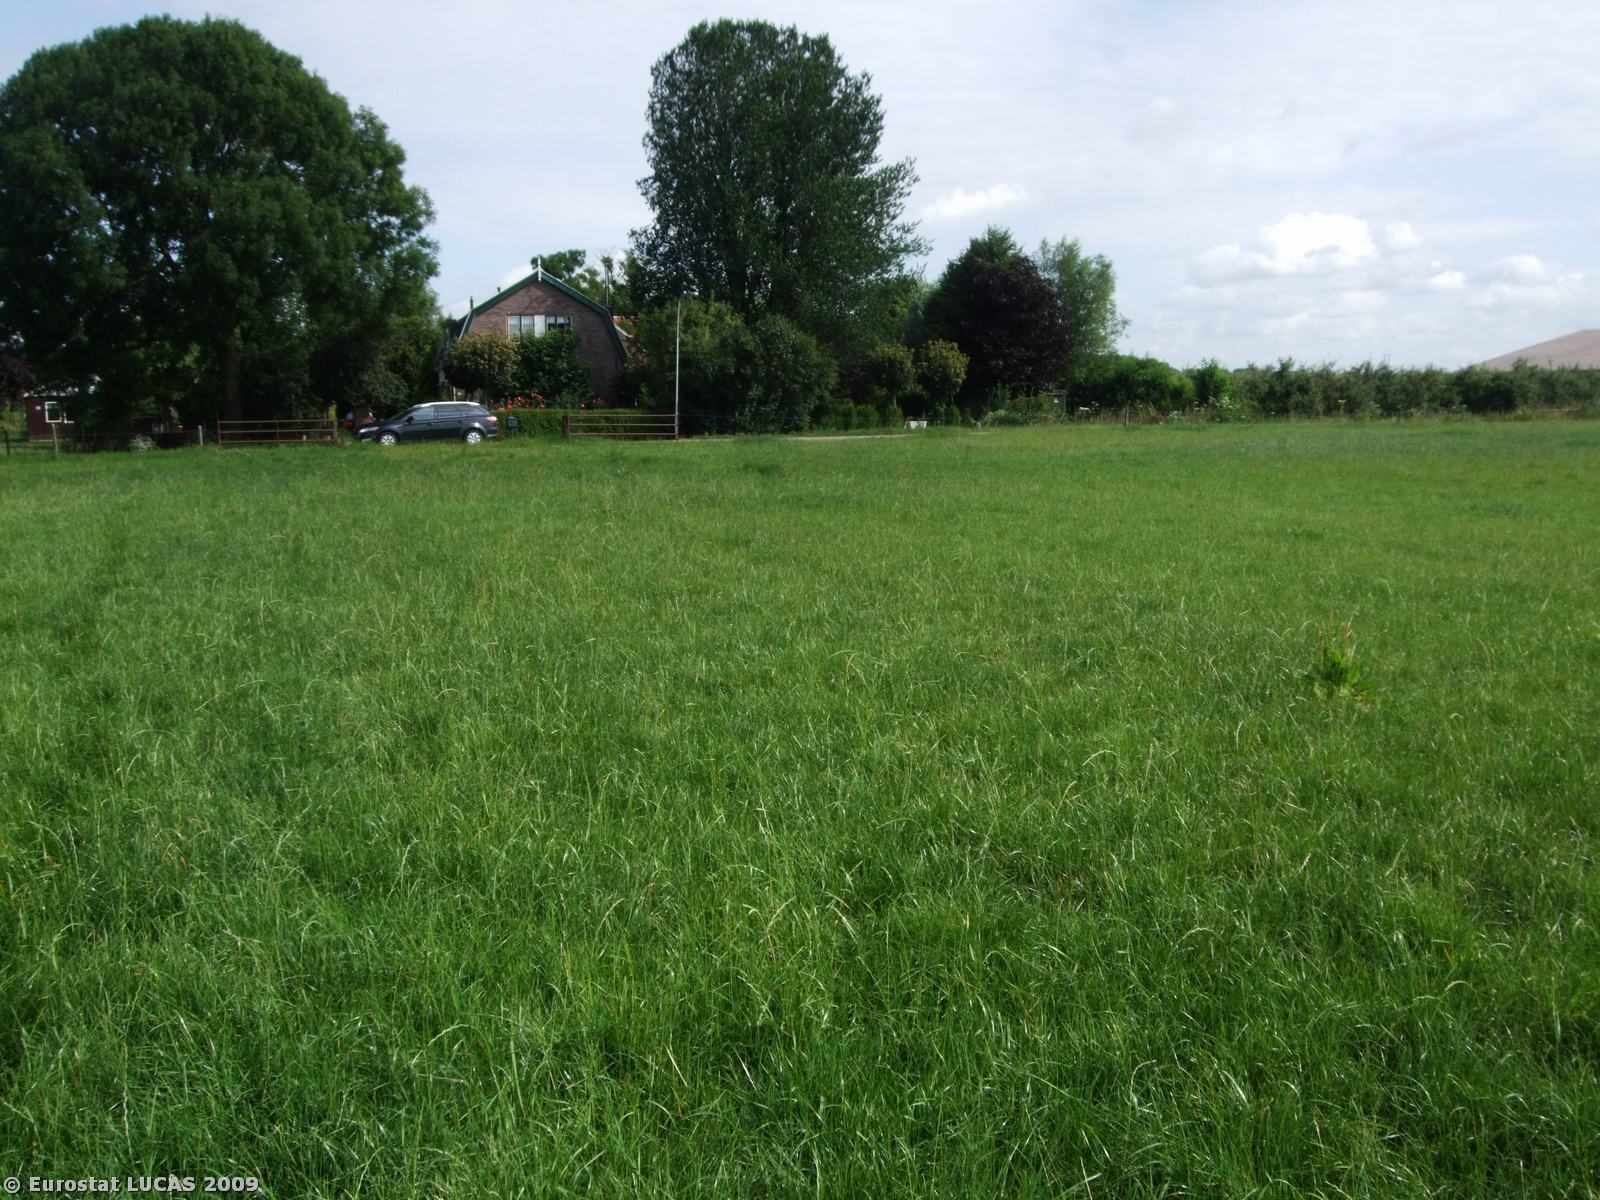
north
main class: Grassland
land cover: Grassland without tree/shrub cover
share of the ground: > 75 %
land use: Agriculture (excluding fallow land and kitchen gardens)
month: July
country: NL
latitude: 51.9458
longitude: 5.3863
